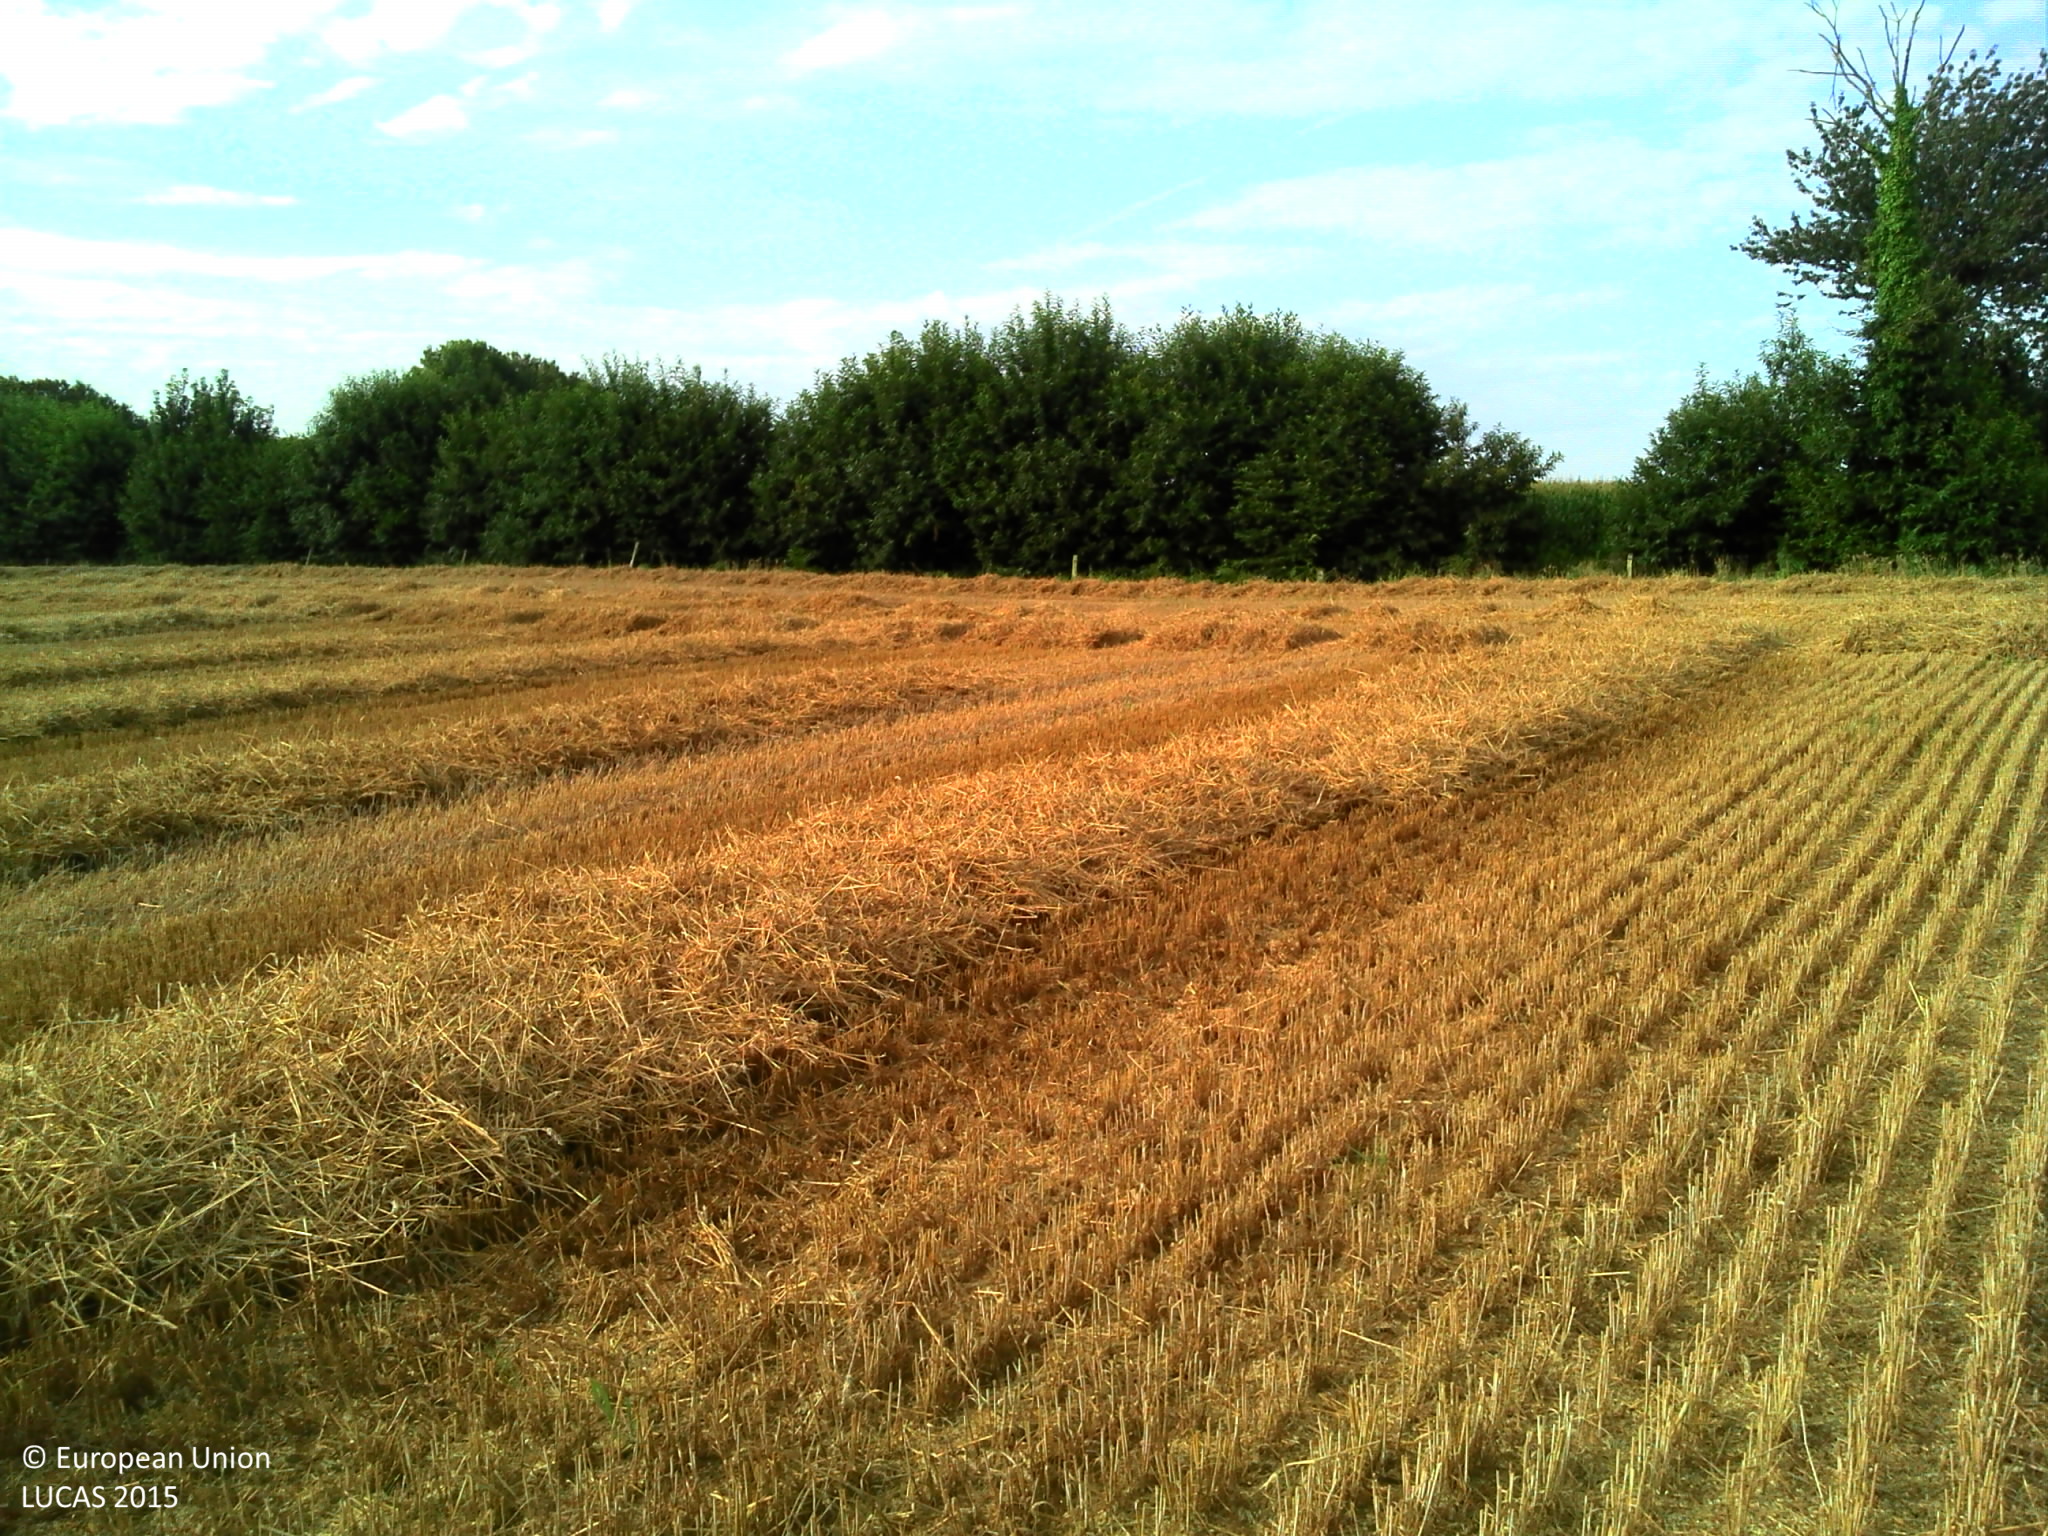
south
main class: Cropland
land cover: Common wheat
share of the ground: > 75 %
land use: Agriculture (excluding fallow land and kitchen gardens)
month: August
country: FR
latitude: 48.5309
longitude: -1.2978
